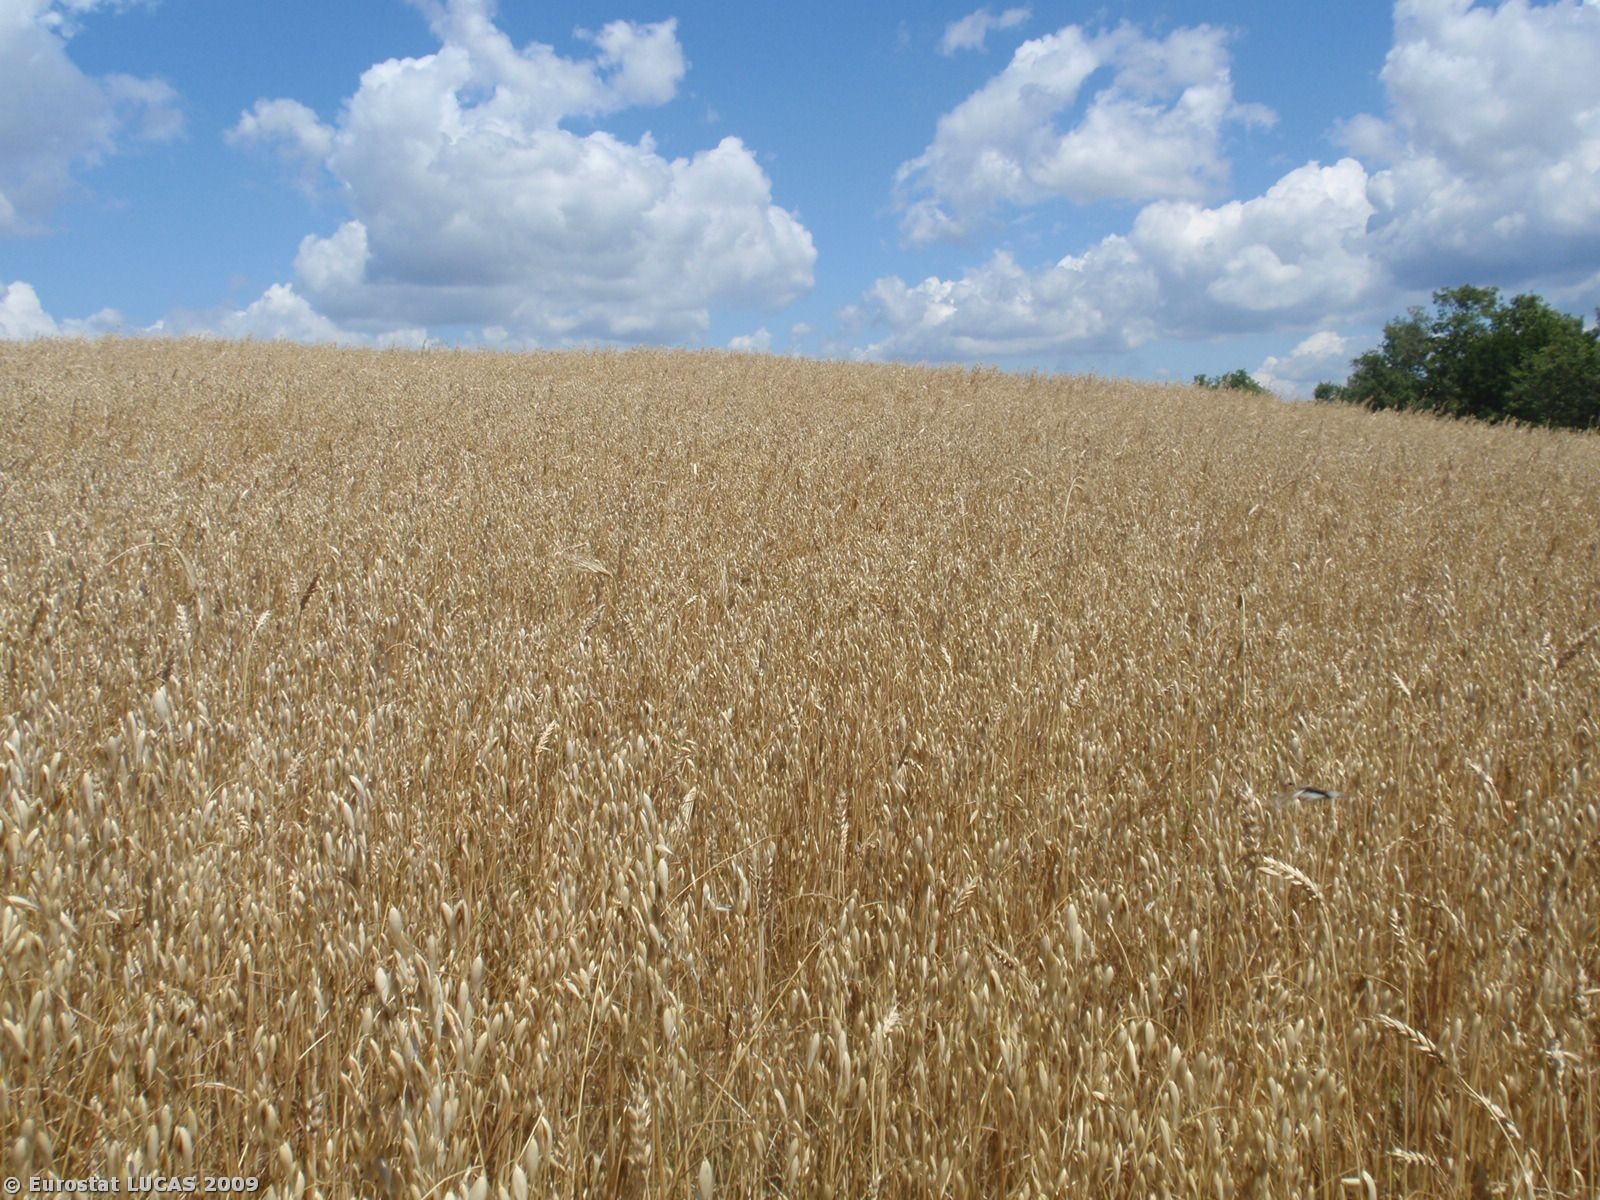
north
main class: Cropland
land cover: Mixed cereals for fodder
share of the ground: > 75 %
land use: Agriculture (excluding fallow land and kitchen gardens)
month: June
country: IT
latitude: 40.3144
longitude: 16.0828
